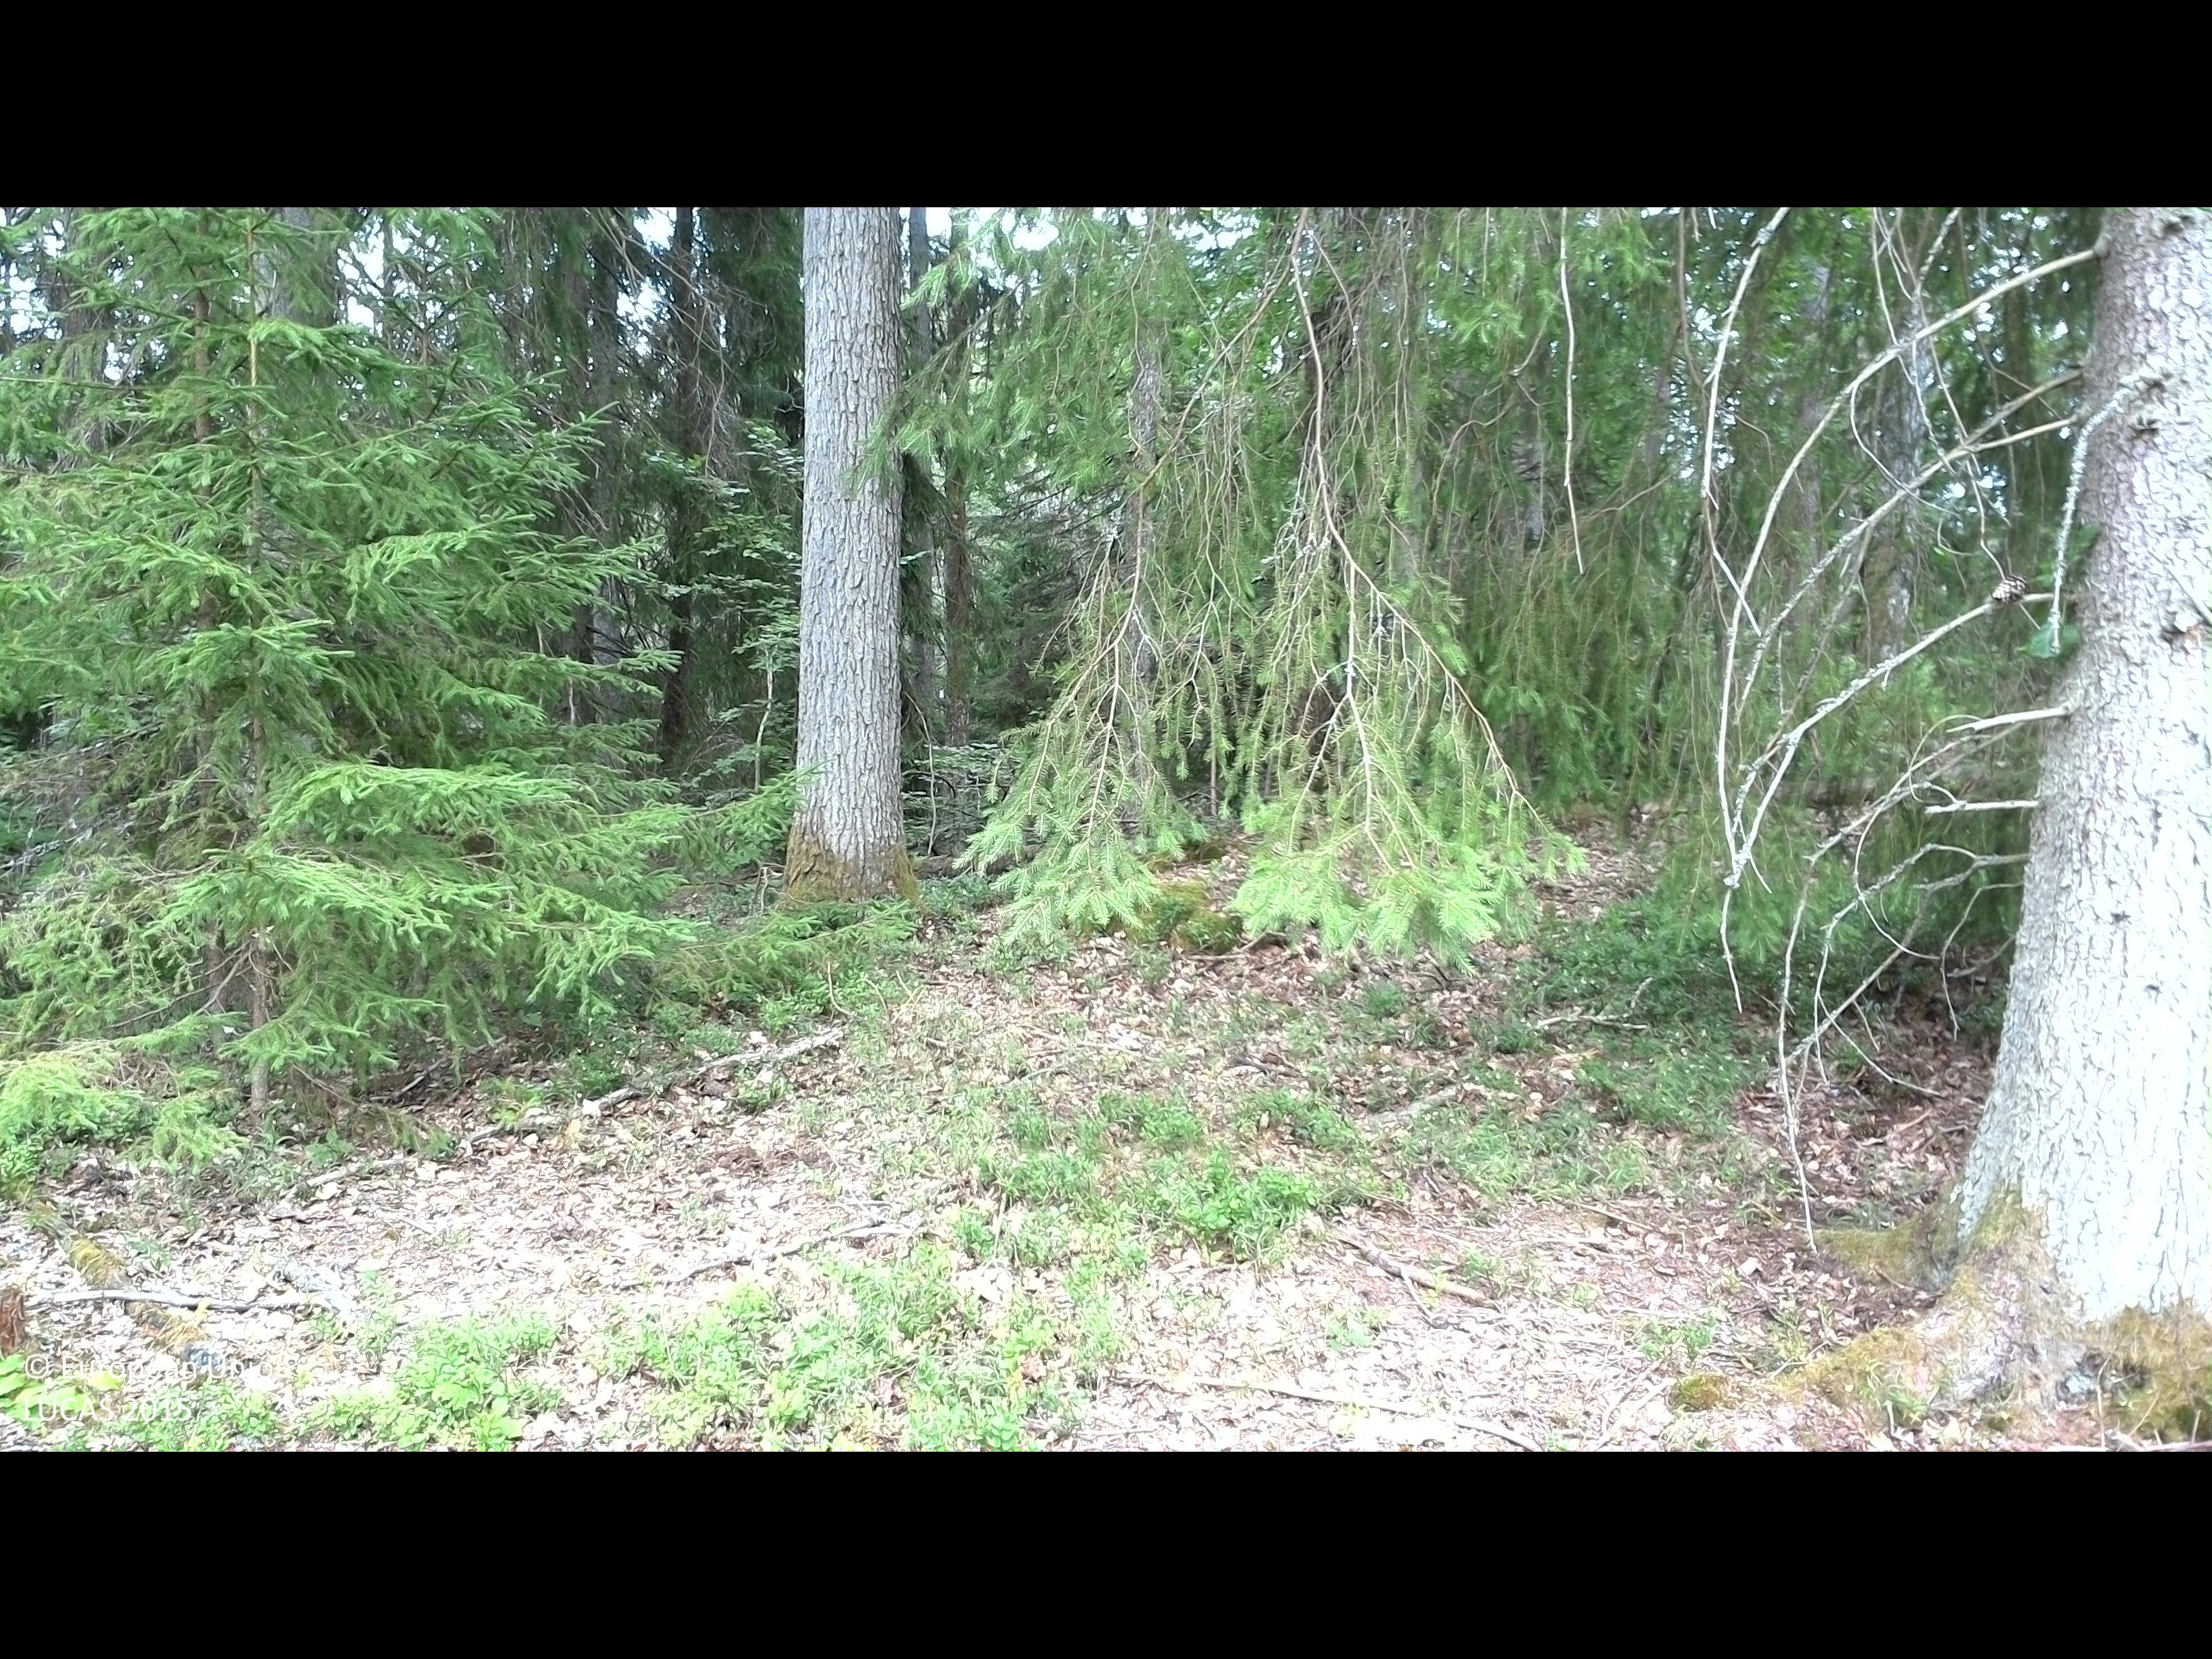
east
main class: Woodland
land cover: Spruce dominated mixed woodland
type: boreal forest
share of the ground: 50 - 75 %
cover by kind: coniferous forest trees 35 %, shrubs 30 %, broadleaved forest trees 15 %, herbaceous plants 10 %, lichens and mosses 10 %
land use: Forestry
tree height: > 5 m
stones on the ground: < 10 %
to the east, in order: Spruce dominated mixed woodland; Spruce dominated coniferous woodland; Broadleaved woodland; Spruce dominated mixed woodland; Inland fresh water bodies; Pine dominated mixed woodland
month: July
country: SE
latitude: 56.3477
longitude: 15.3223
